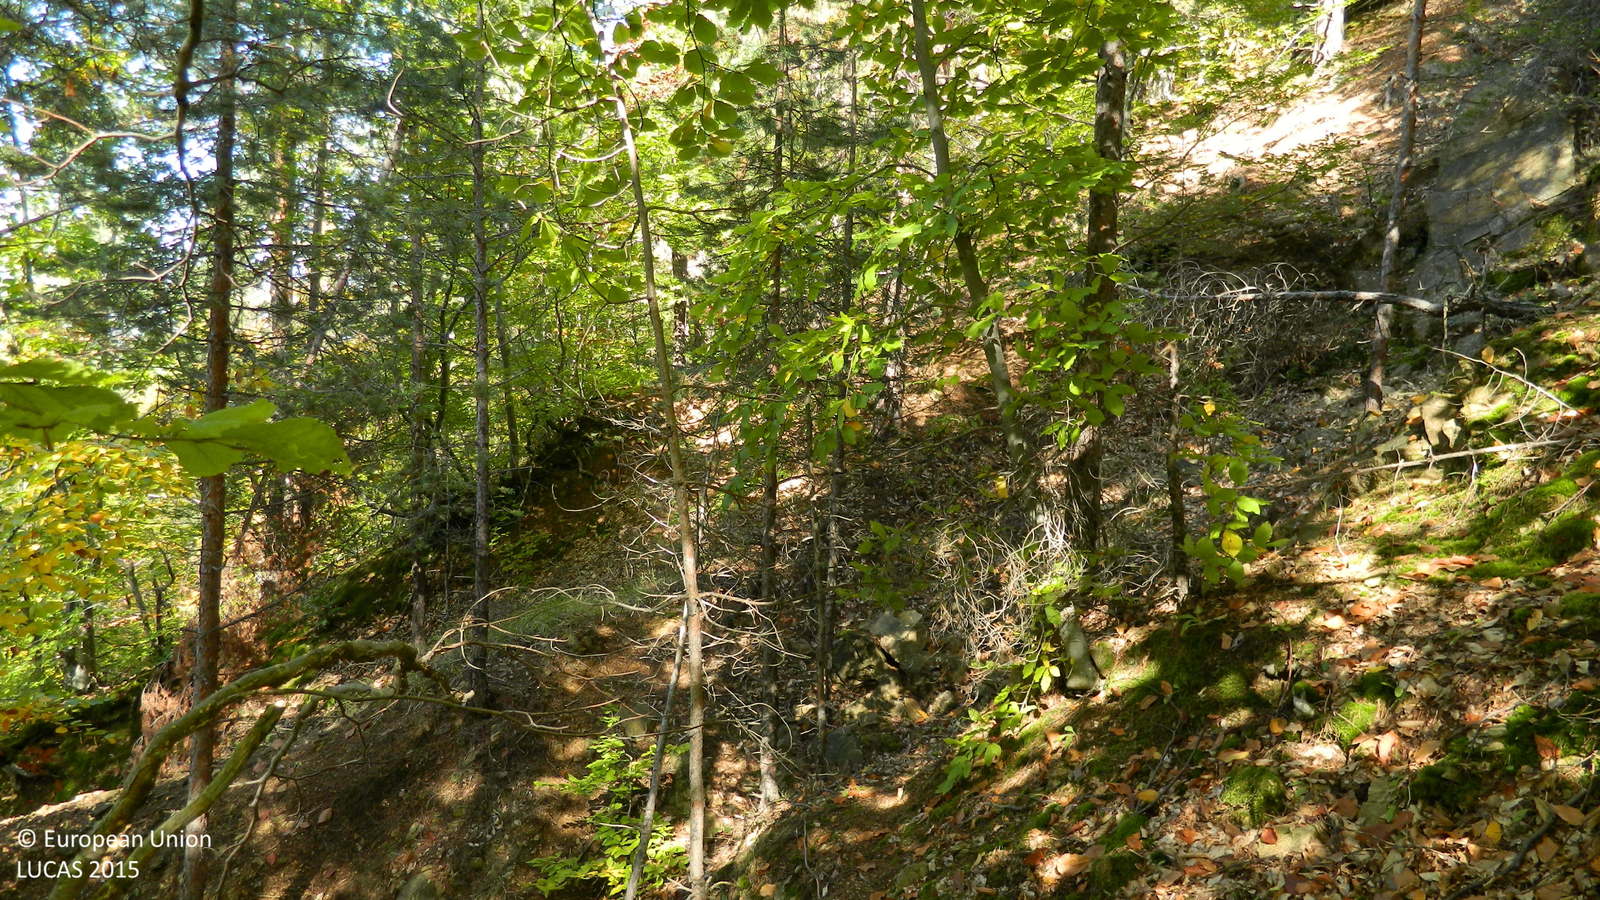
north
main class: Woodland
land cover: Pine dominated mixed woodland
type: hemiboreal forest and nemoral coniferous forest and mixed broadleaved-coniferous forest
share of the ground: > 75 %
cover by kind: coniferous forest trees 55 %, broadleaved forest trees 45 %
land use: Forestry
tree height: > 5 m
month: October
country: BG
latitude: 41.6684
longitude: 25.0525
